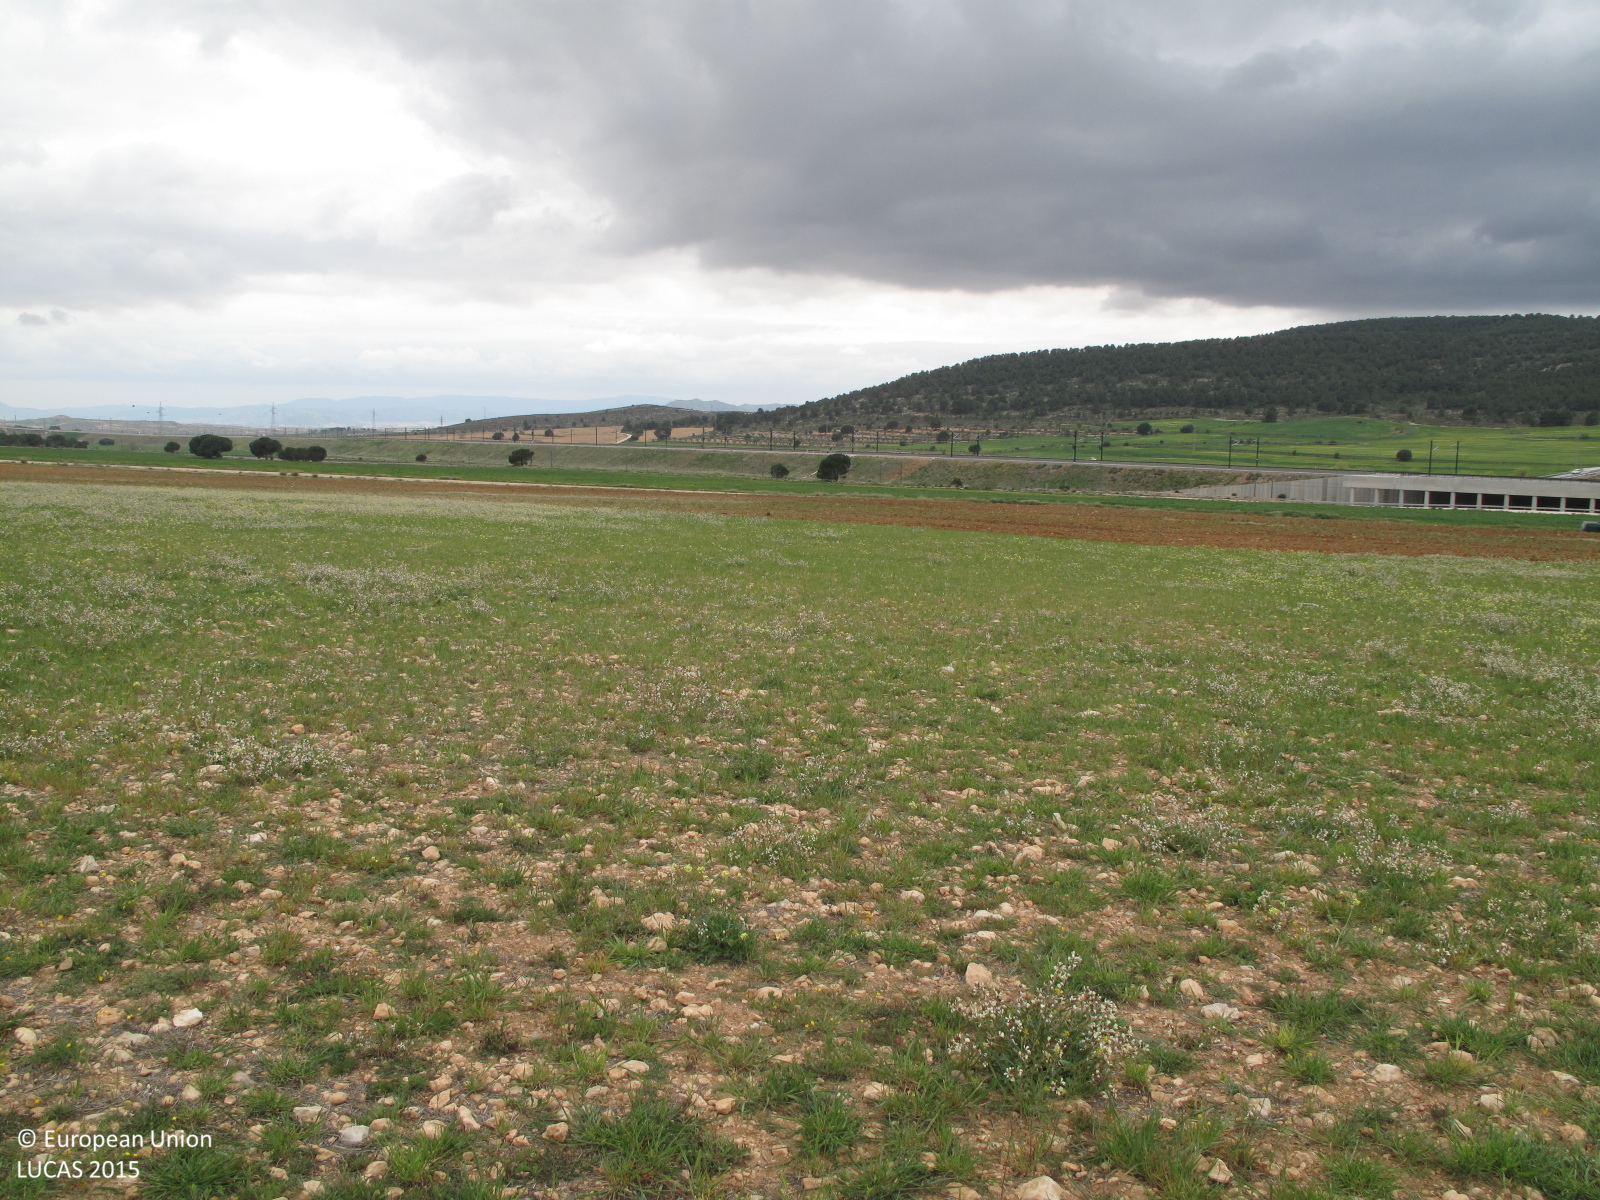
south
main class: Grassland
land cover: Spontaneously vegetated surfaces
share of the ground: > 75 %
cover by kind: herbaceous plants 90 %, unconsolidated bare surface 10 %
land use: Fallow land
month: April
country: ES
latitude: 38.7929
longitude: -0.9647
